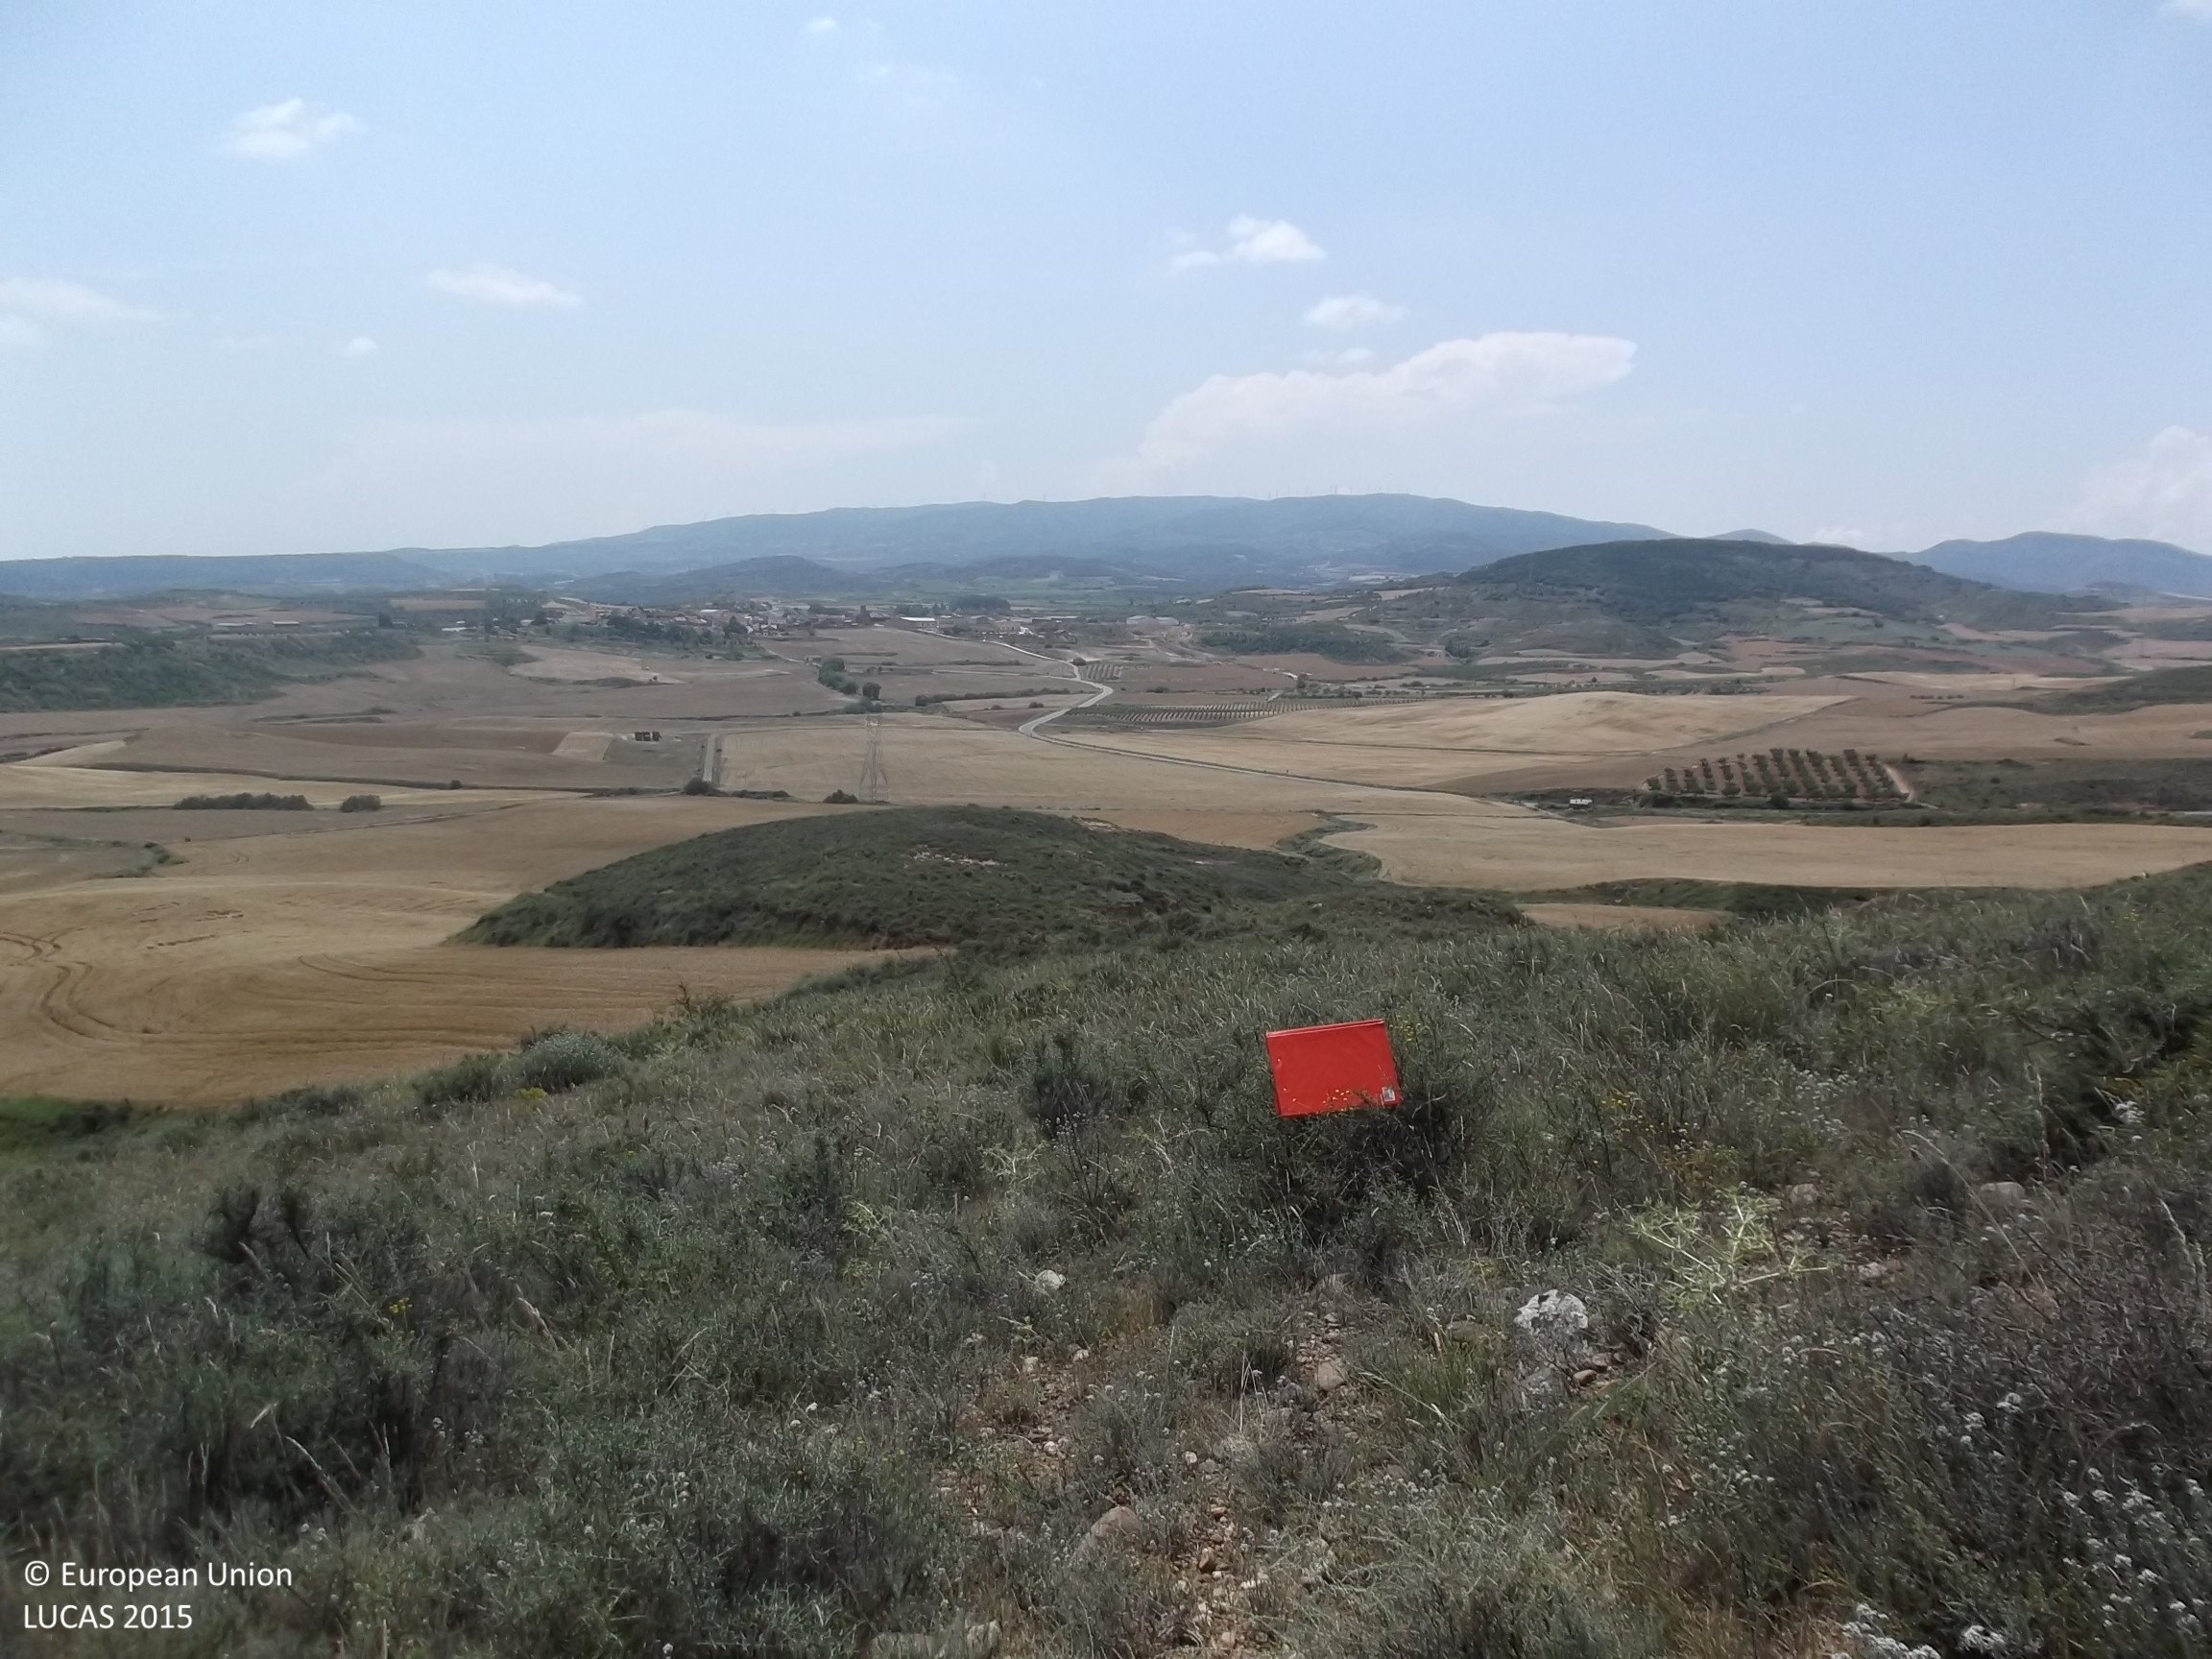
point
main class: Shrubland
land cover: Shrubland without tree cover
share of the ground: > 75 %
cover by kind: shrubs 75 %, unconsolidated bare surface 15 %, herbaceous plants 5 %
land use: Semi-natural and natural areas not in use
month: June
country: ES
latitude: 42.3642
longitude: -2.2444
